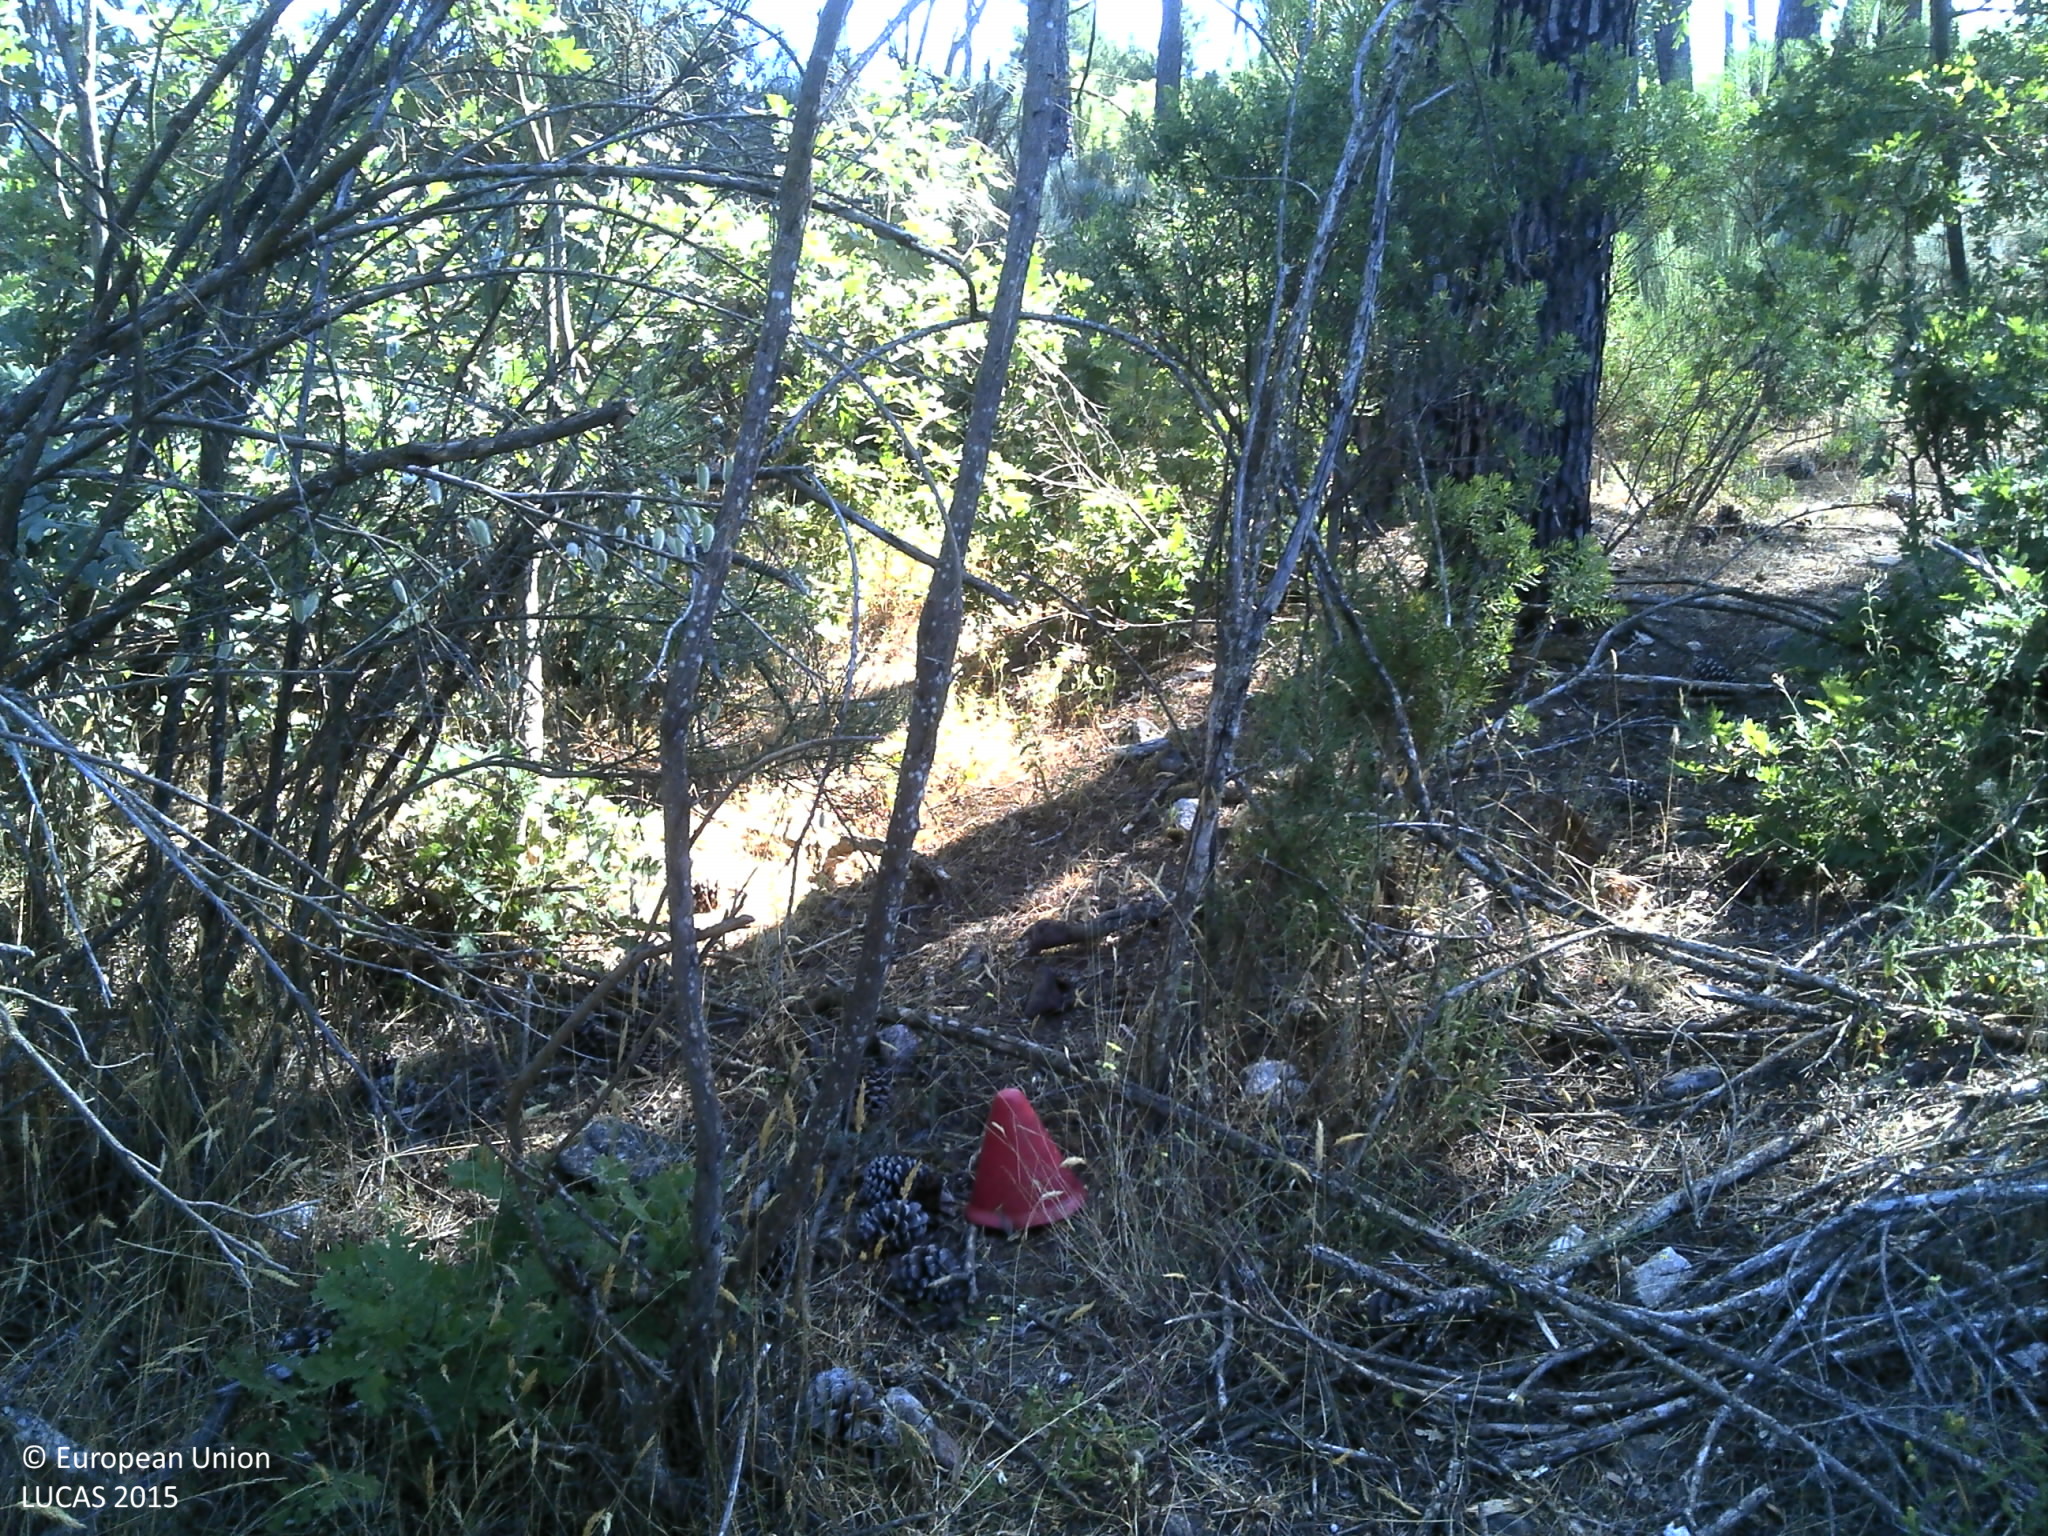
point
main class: Woodland
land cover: Pine dominated mixed woodland
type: coniferous forest of the mediterranean region
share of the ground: 50 - 75 %
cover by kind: shrubs 50 %, coniferous forest trees 30 %, broadleaved forest trees 10 %, unconsolidated bare surface 10 %
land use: Forestry
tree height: > 5 m
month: June
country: PT
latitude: 40.7597
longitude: -7.2253
